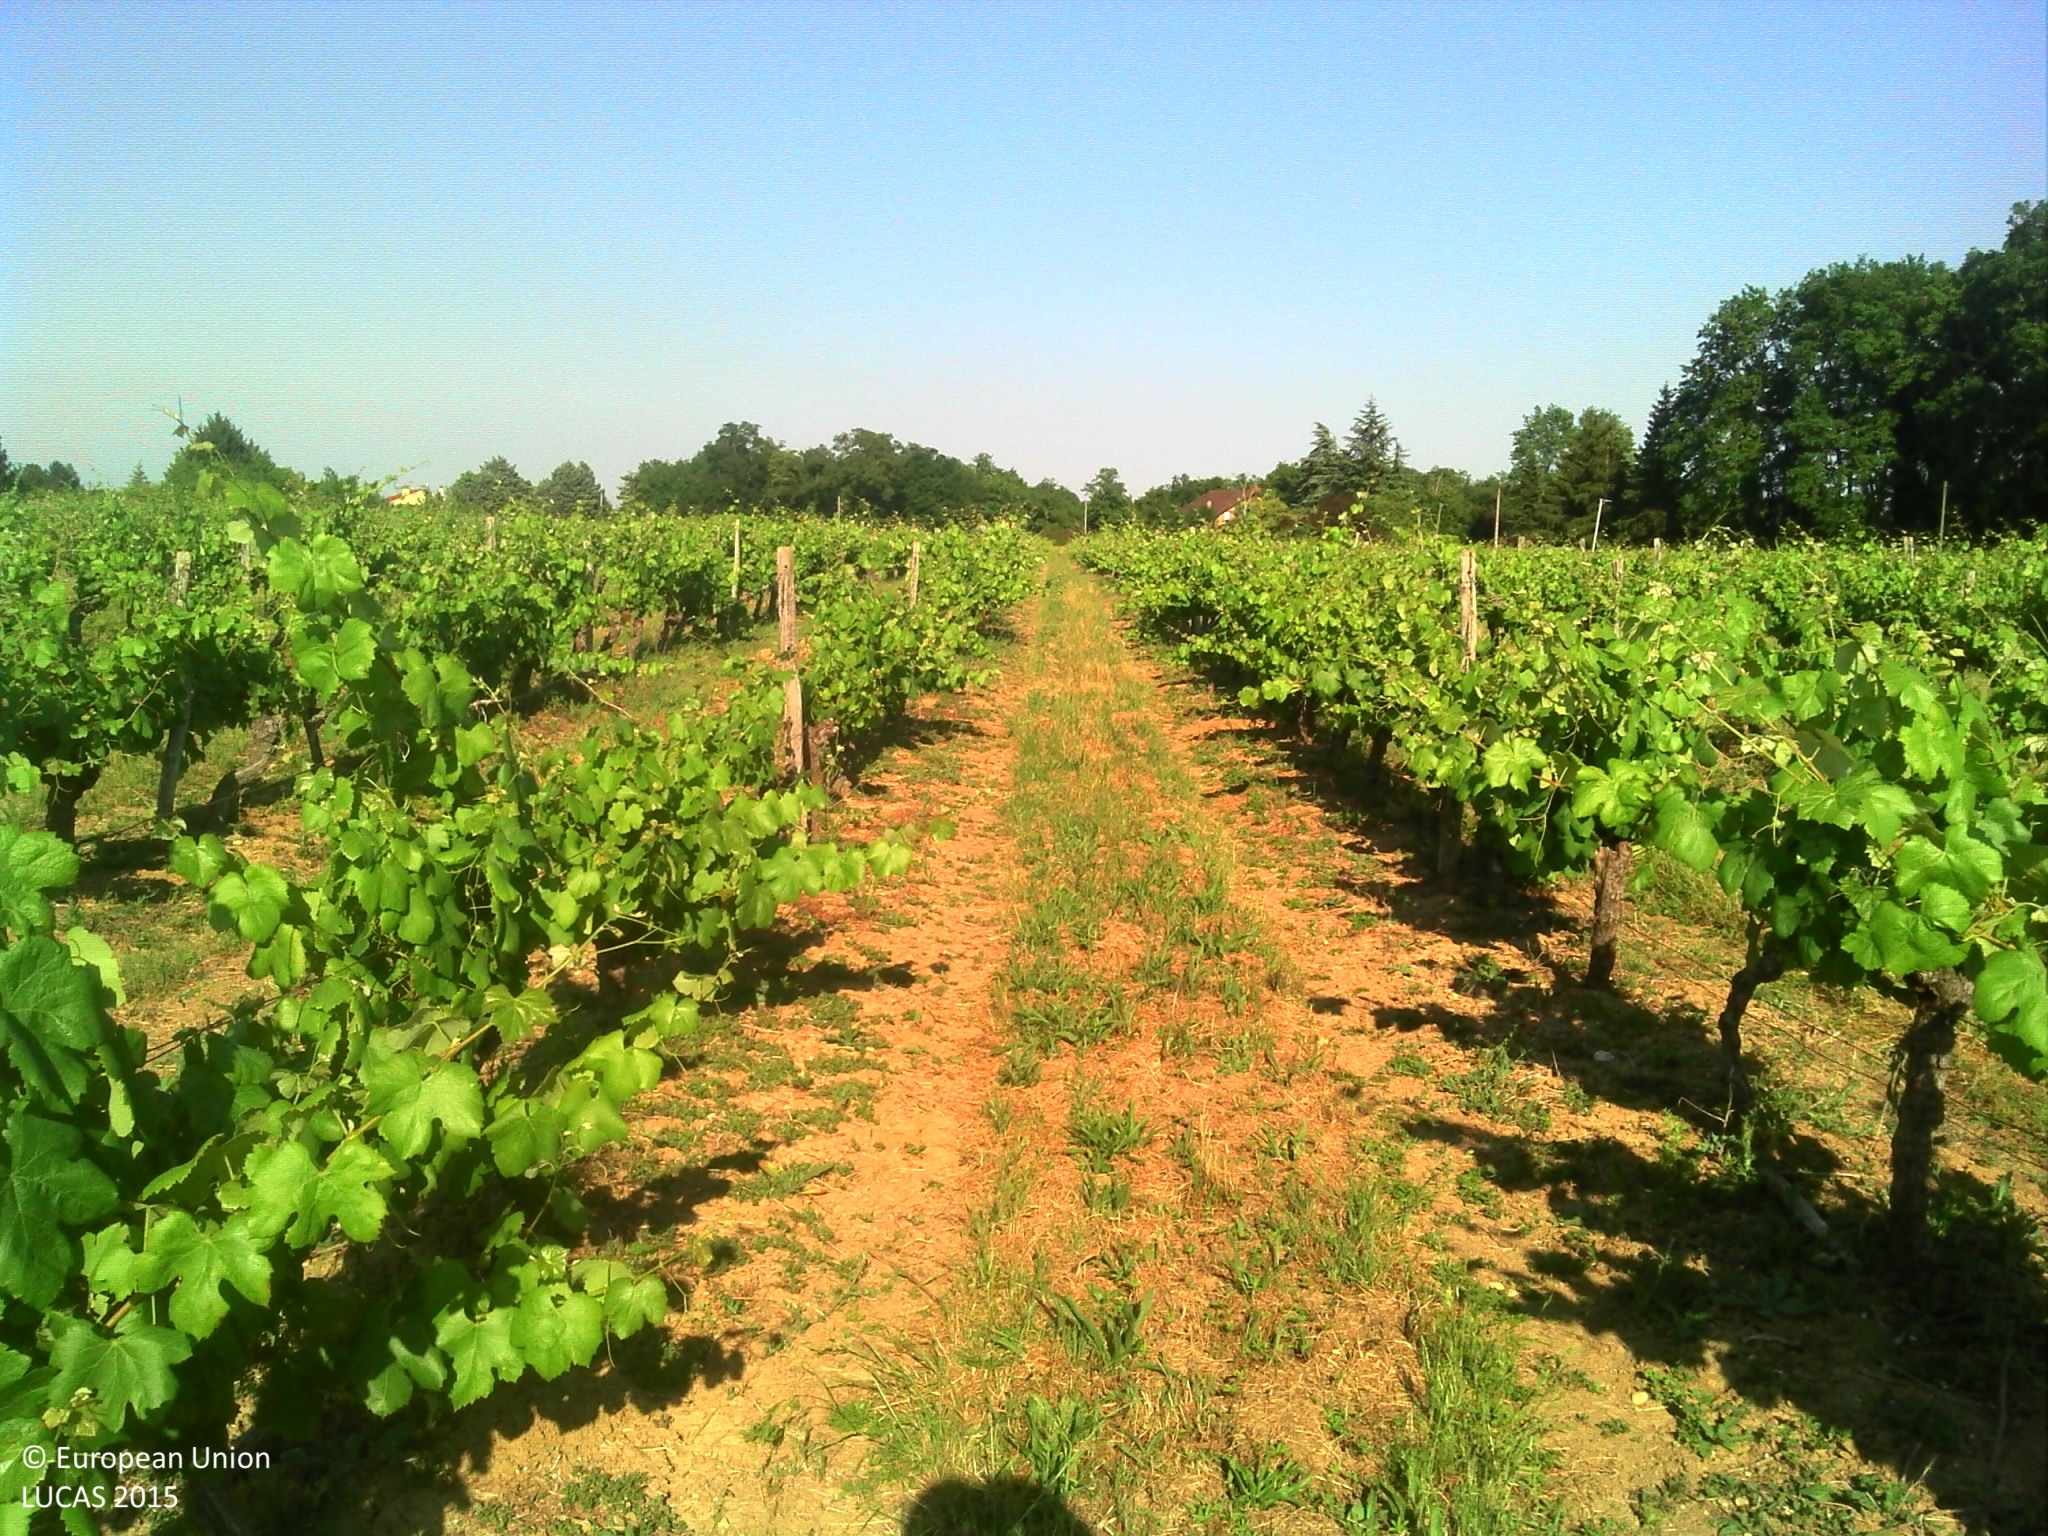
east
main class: Cropland
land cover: Vineyards
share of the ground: 10 - 25 %
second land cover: Spontaneously vegetated surfaces
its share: 25 - 50 %
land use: Agriculture (excluding fallow land and kitchen gardens)
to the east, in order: Vineyards; Spontaneously vegetated surfaces; Grassland without tree/shrub cover; Temporary grasslands; Ditches and canals; Paved roads, cycling and walking lanes; Electric lines; Grass margins; Broadleaved woodland
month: June
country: FR
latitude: 43.9283
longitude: 1.9441
